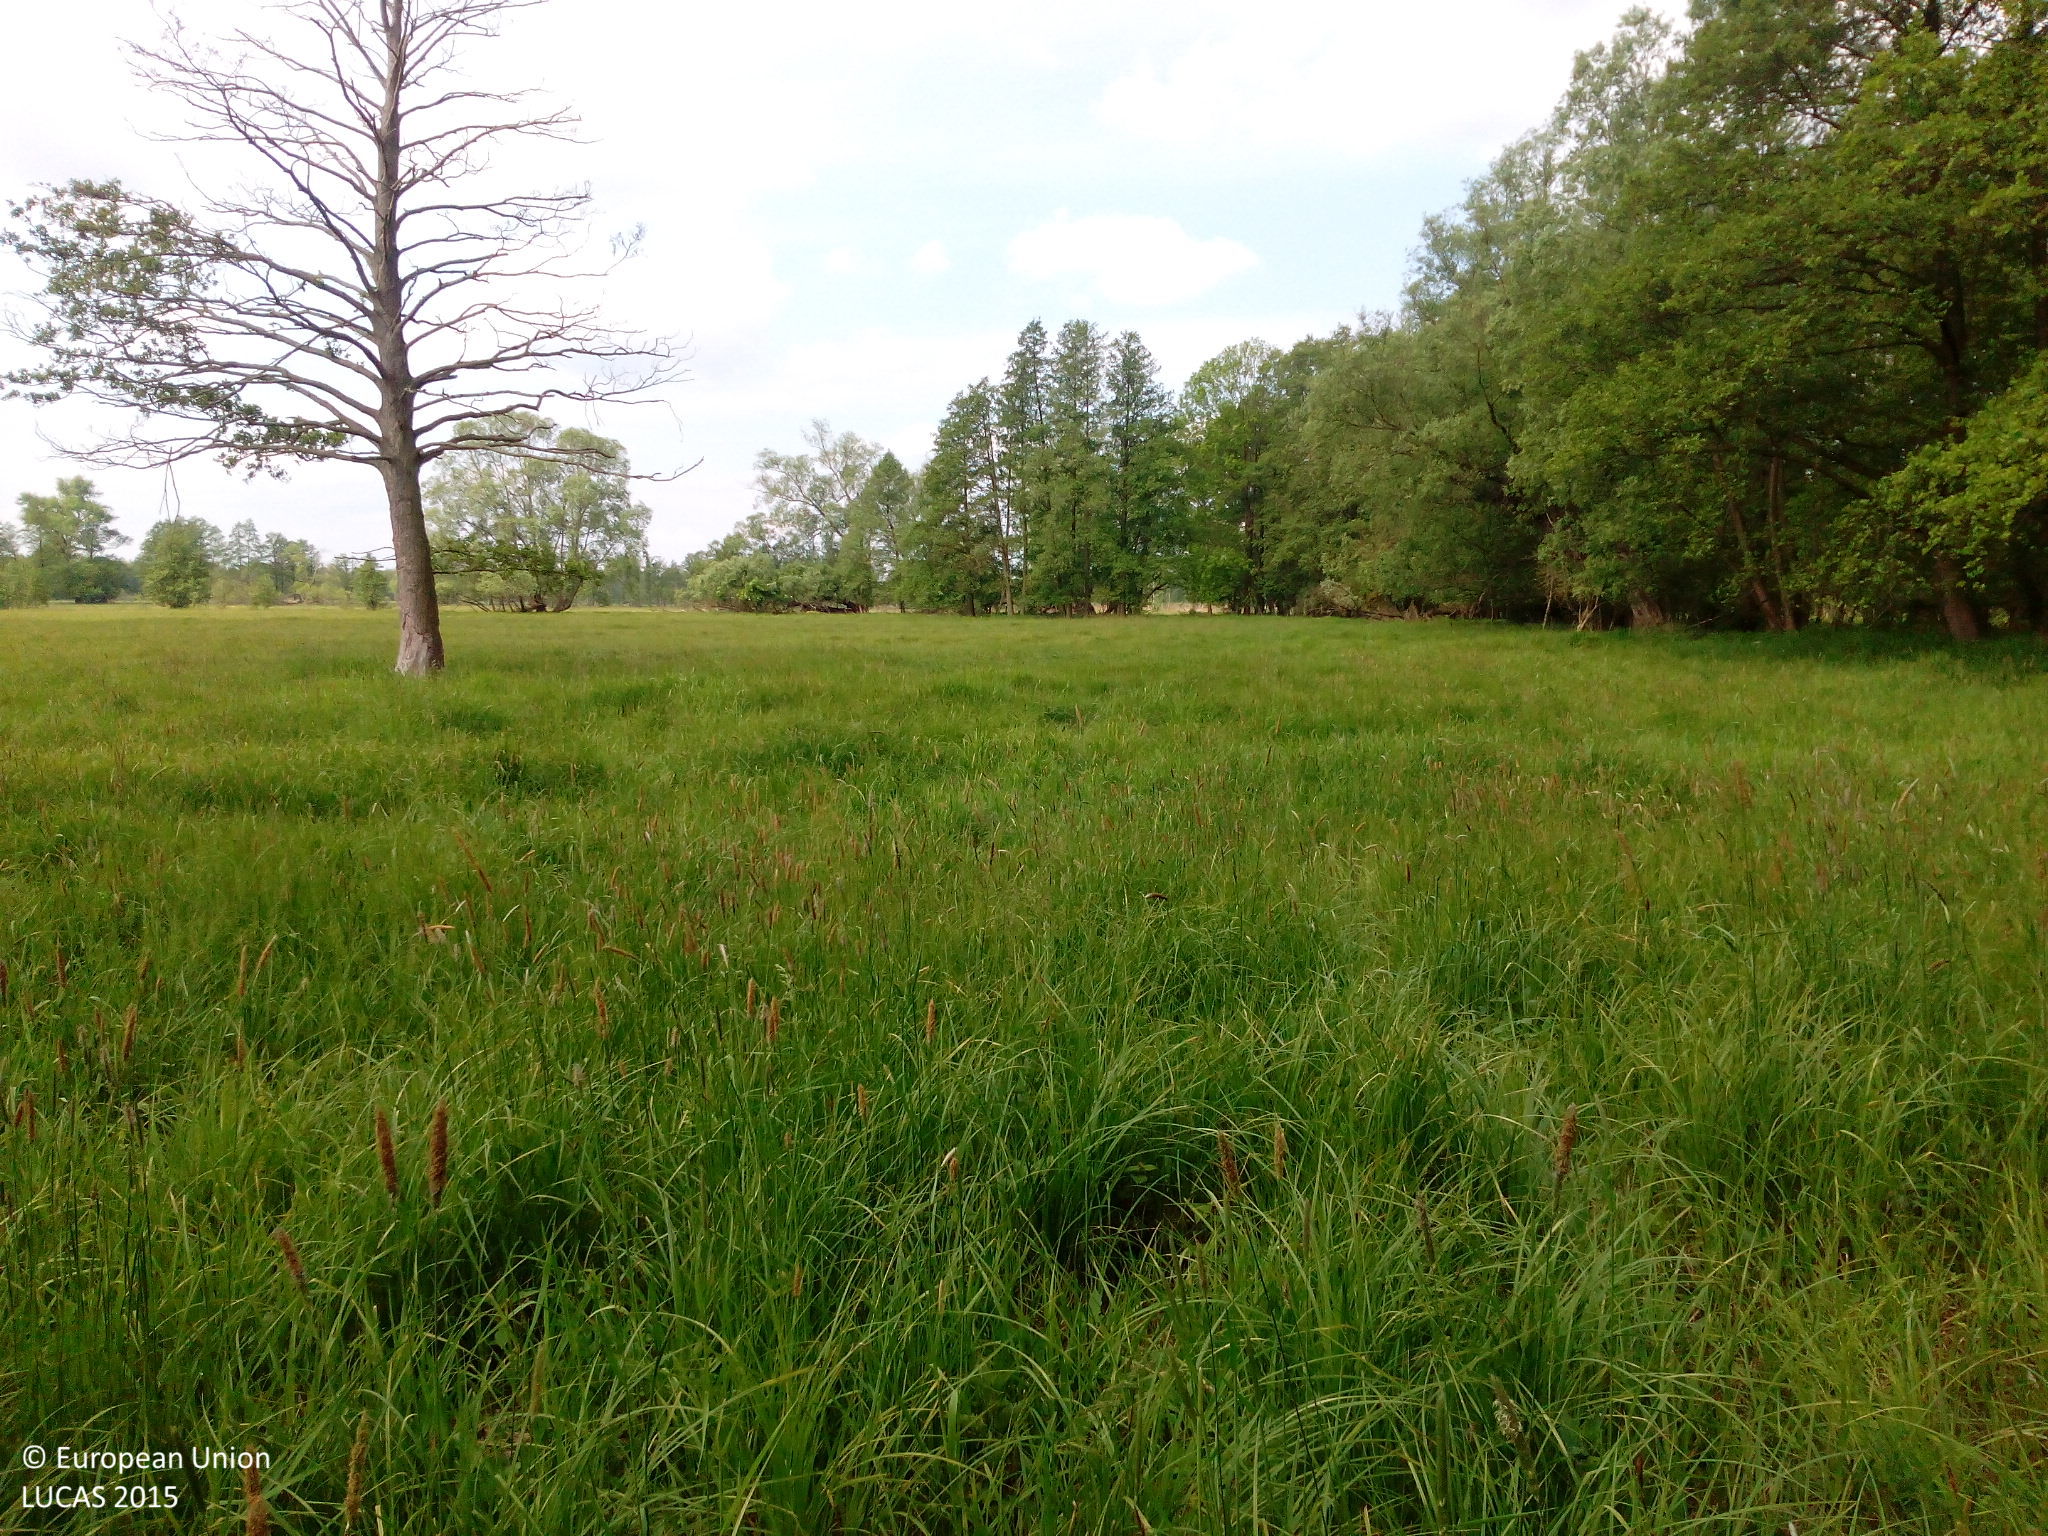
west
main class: Grassland
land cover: Grassland without tree/shrub cover
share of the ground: > 75 %
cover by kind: herbaceous plants 100 %
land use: Agriculture (excluding fallow land and kitchen gardens)
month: May
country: DE
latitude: 51.8405
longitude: 14.0505
